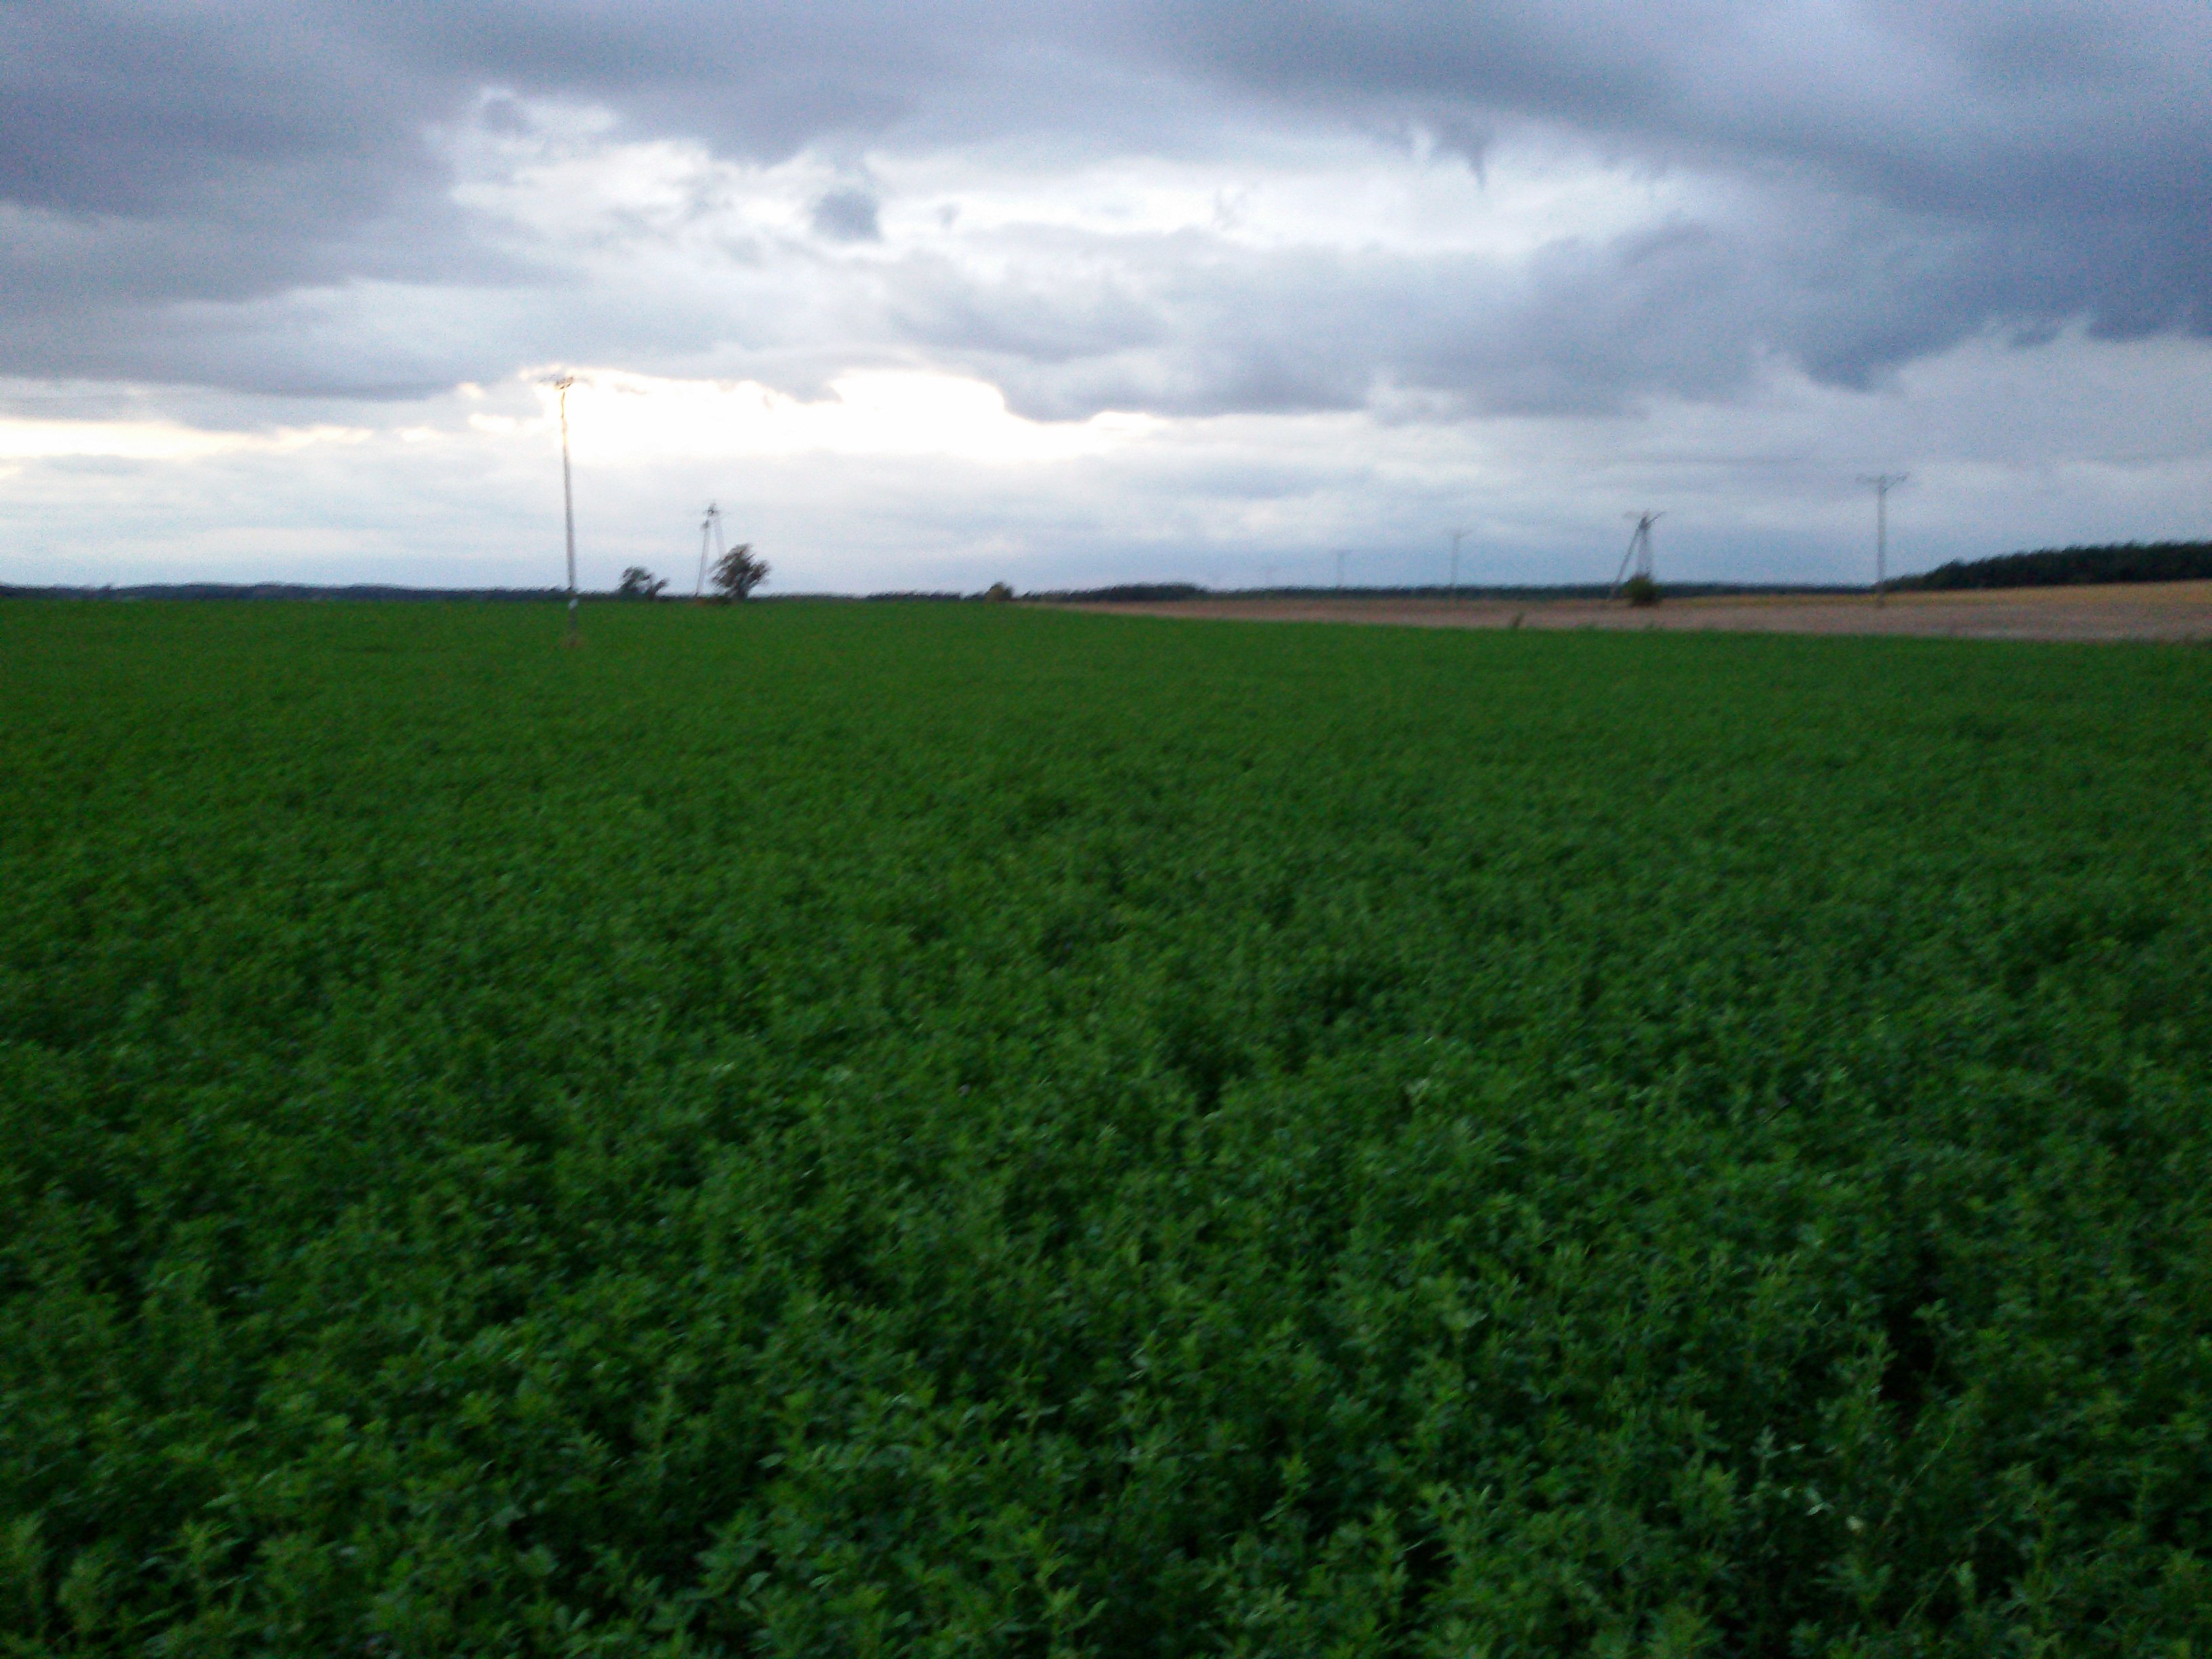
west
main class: Cropland
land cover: Lucerne
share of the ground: > 75 %
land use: Agriculture (excluding fallow land and kitchen gardens)
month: September
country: PL
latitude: 53.0147
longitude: 17.6597
